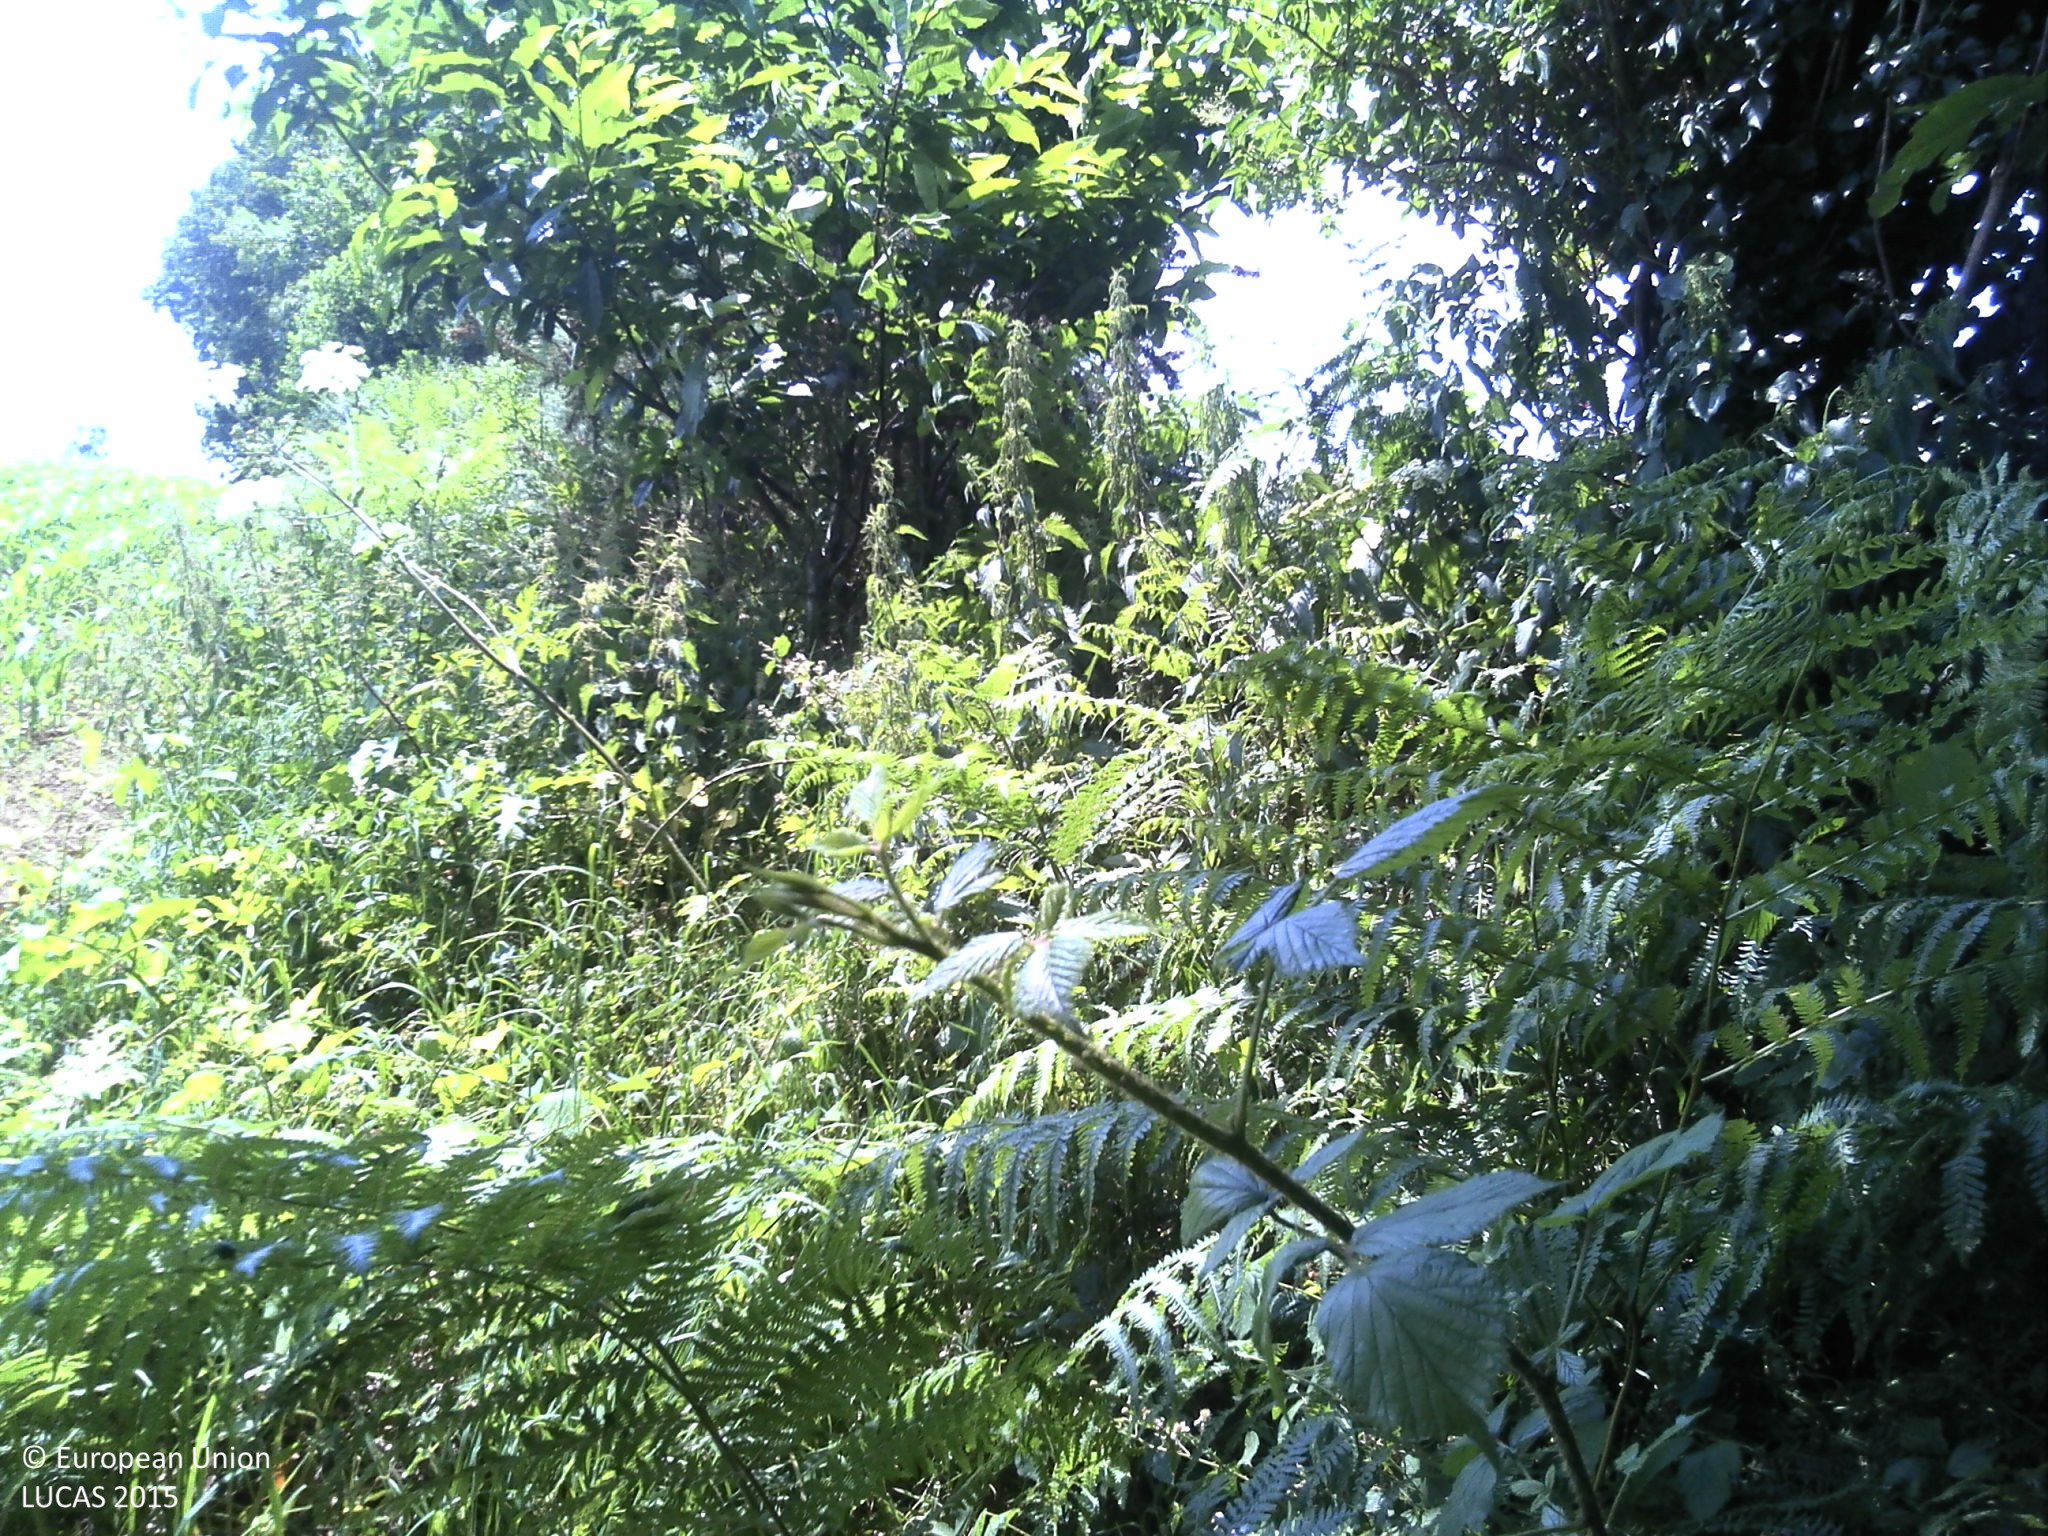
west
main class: Woodland
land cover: Broadleaved woodland
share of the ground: > 75 %
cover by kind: broadleaved forest trees 100 %
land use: Agriculture (excluding fallow land and kitchen gardens)
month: June
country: FR
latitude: 48.1869
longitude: -3.6800
